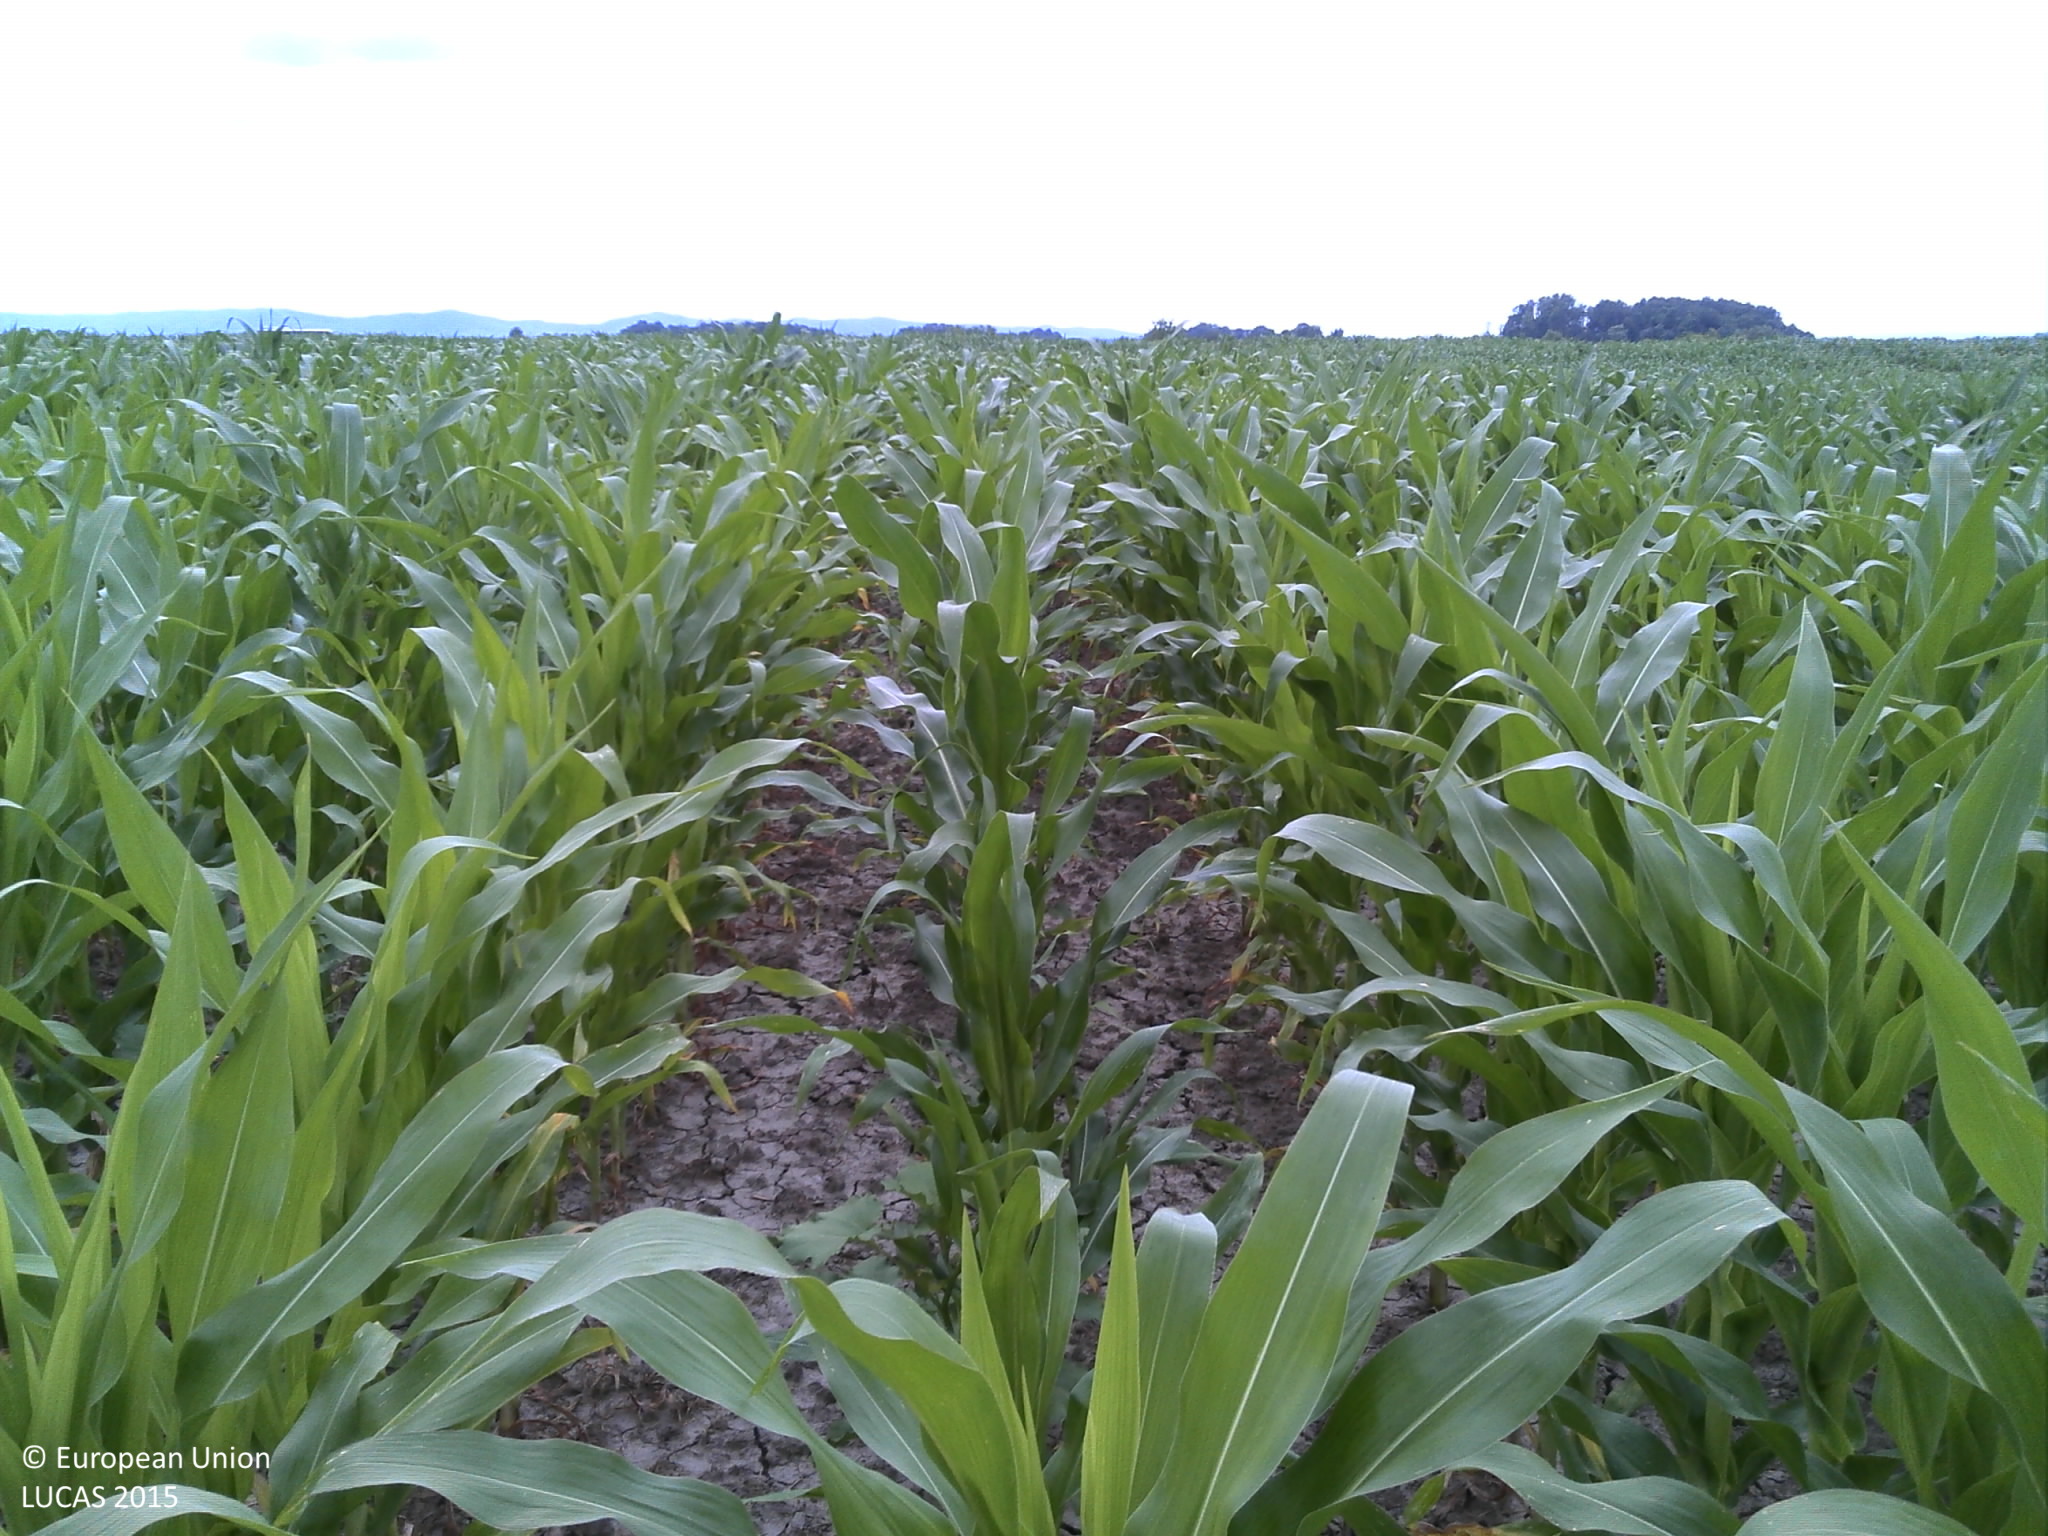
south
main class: Cropland
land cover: Maize
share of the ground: 50 - 75 %
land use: Agriculture (excluding fallow land and kitchen gardens)
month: June
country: HR
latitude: 45.1940
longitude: 17.5999
